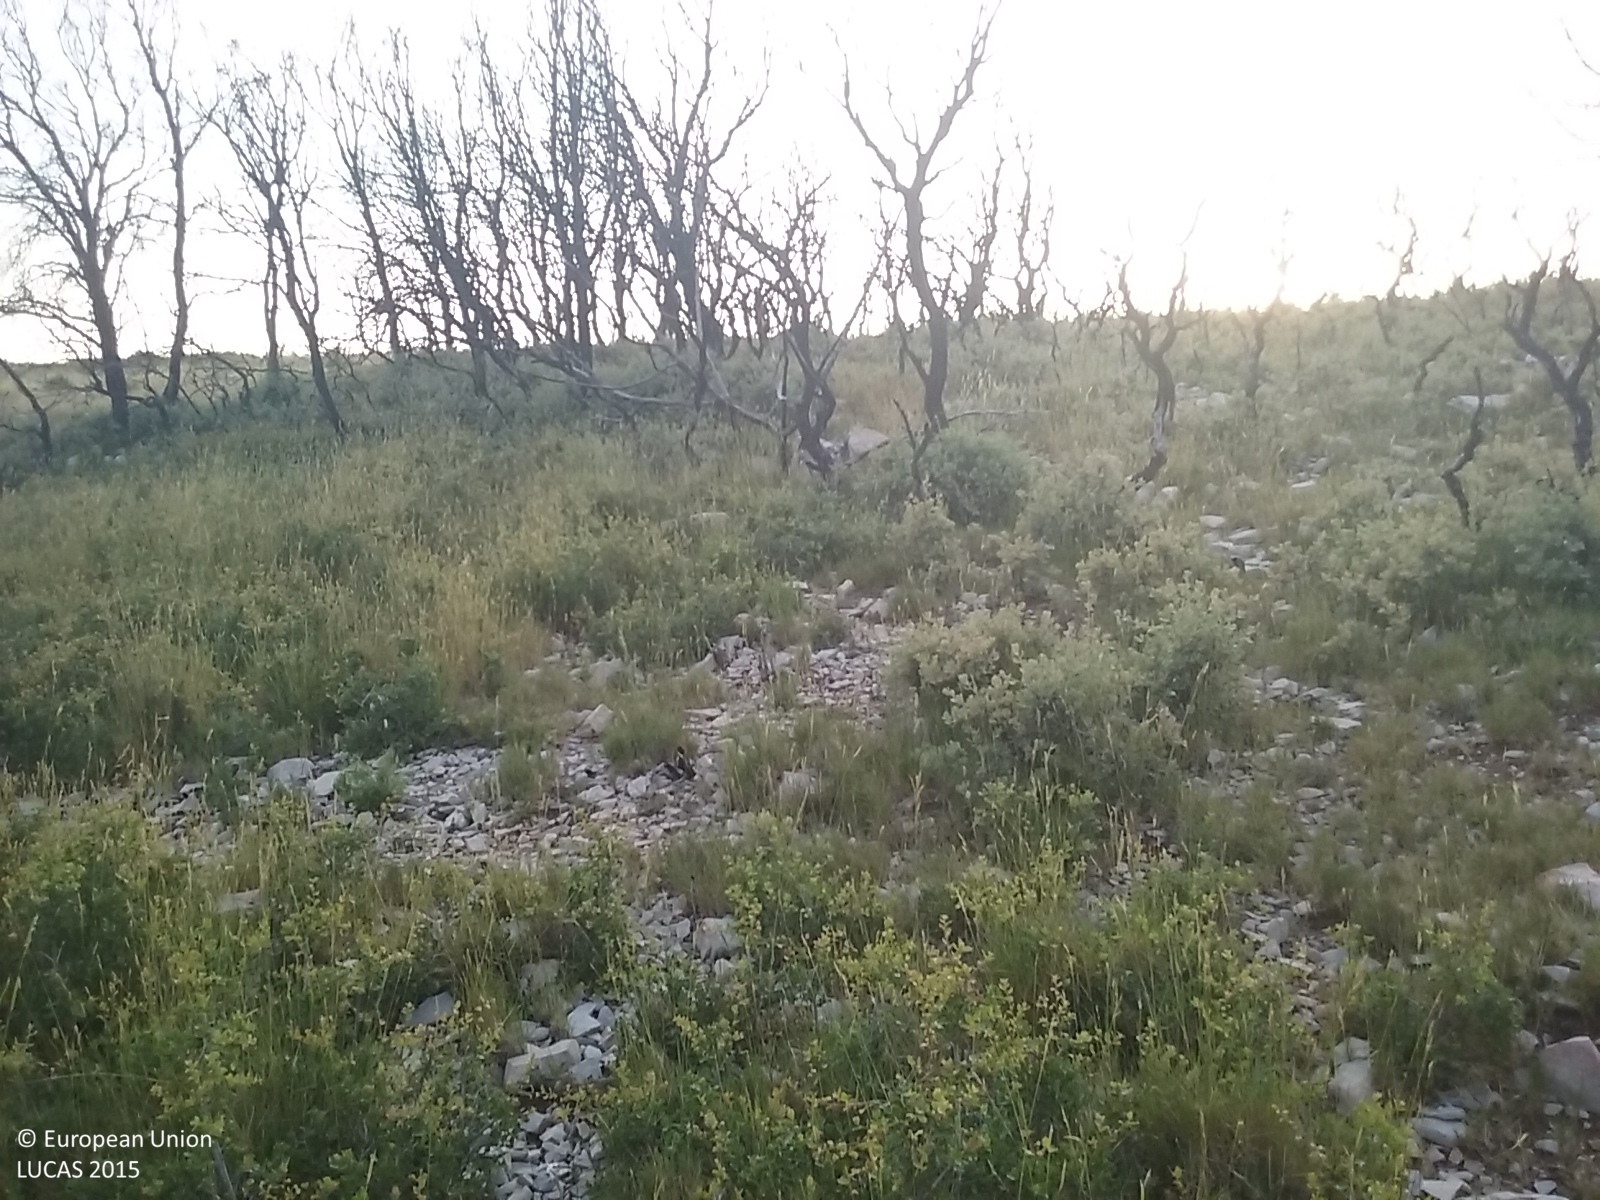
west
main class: Shrubland
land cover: Shrubland without tree cover
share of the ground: 50 - 75 %
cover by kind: shrubs 60 %, herbaceous plants 30 %, unconsolidated bare surface 10 %
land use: Semi-natural and natural areas not in use
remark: Burnt area
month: July
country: ES
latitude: 39.8680
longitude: -0.6531
